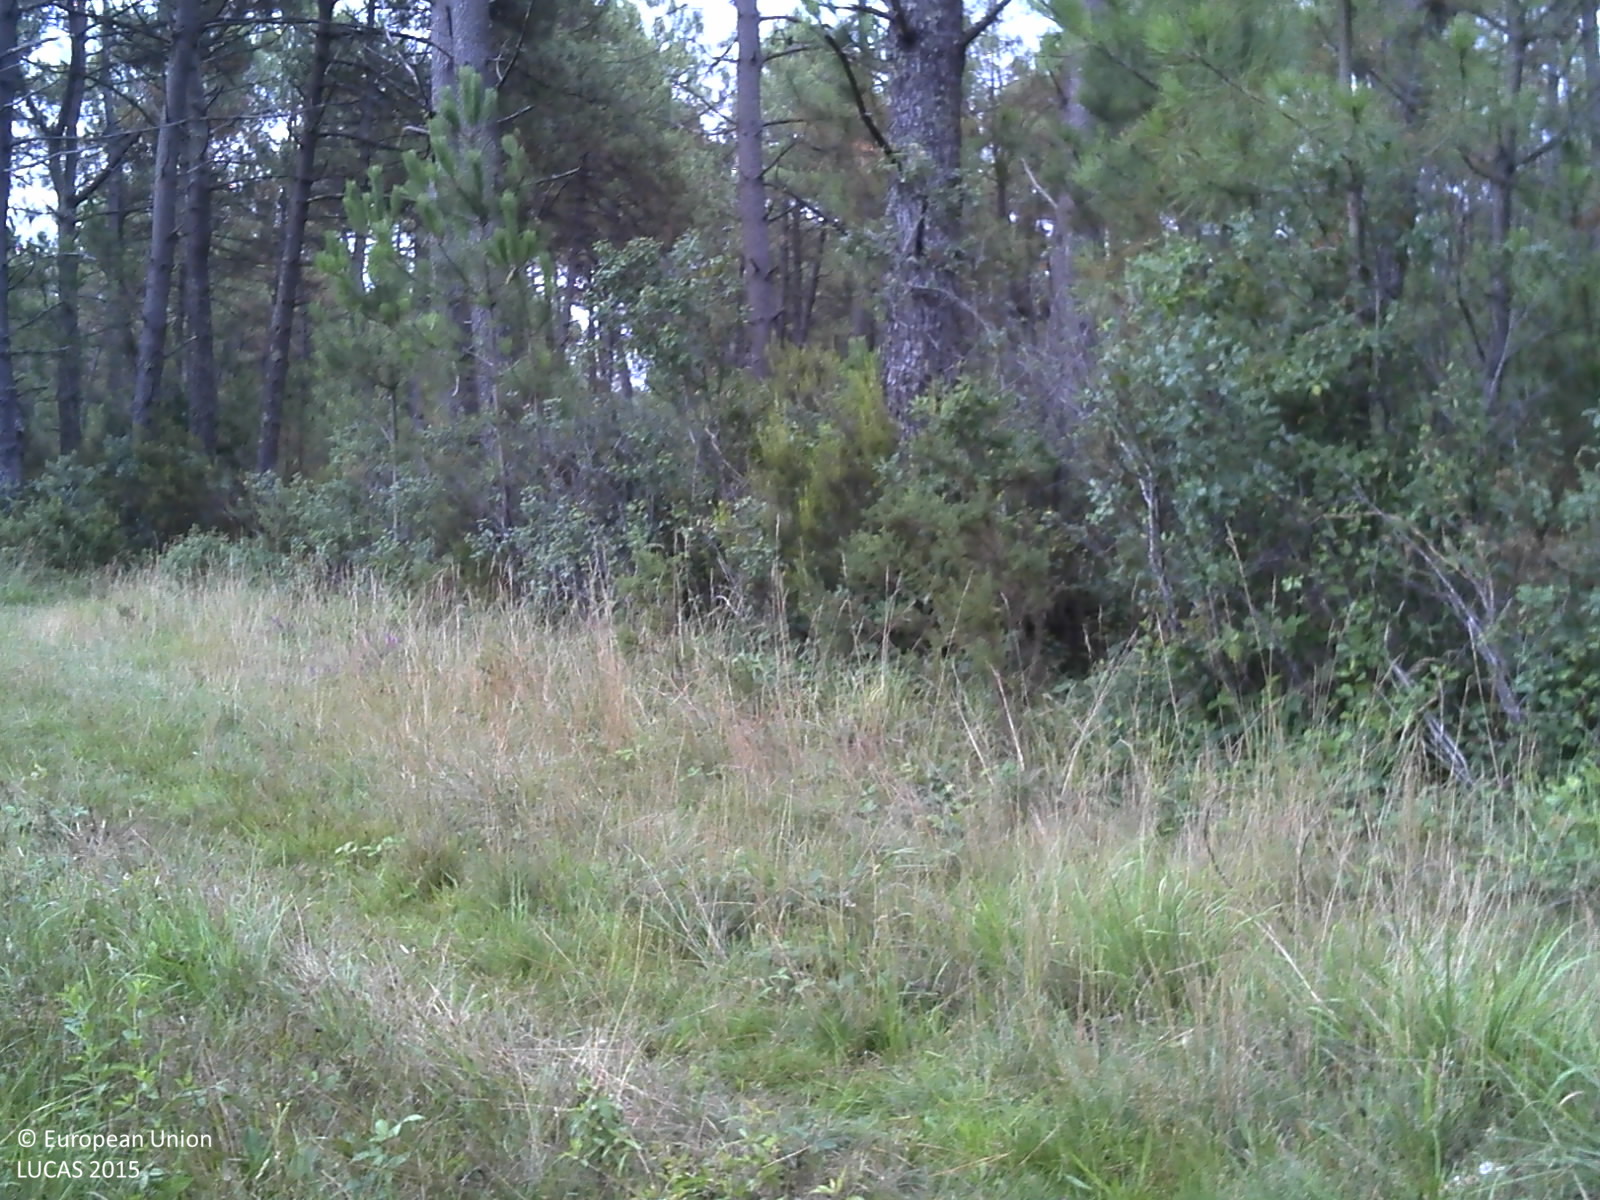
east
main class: Cropland
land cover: Maize
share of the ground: > 75 %
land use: Agriculture (excluding fallow land and kitchen gardens)
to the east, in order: Maize; Grass margins; Tracks; Pine dominated coniferous woodland
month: August
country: FR
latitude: 44.7462
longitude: -0.9978
